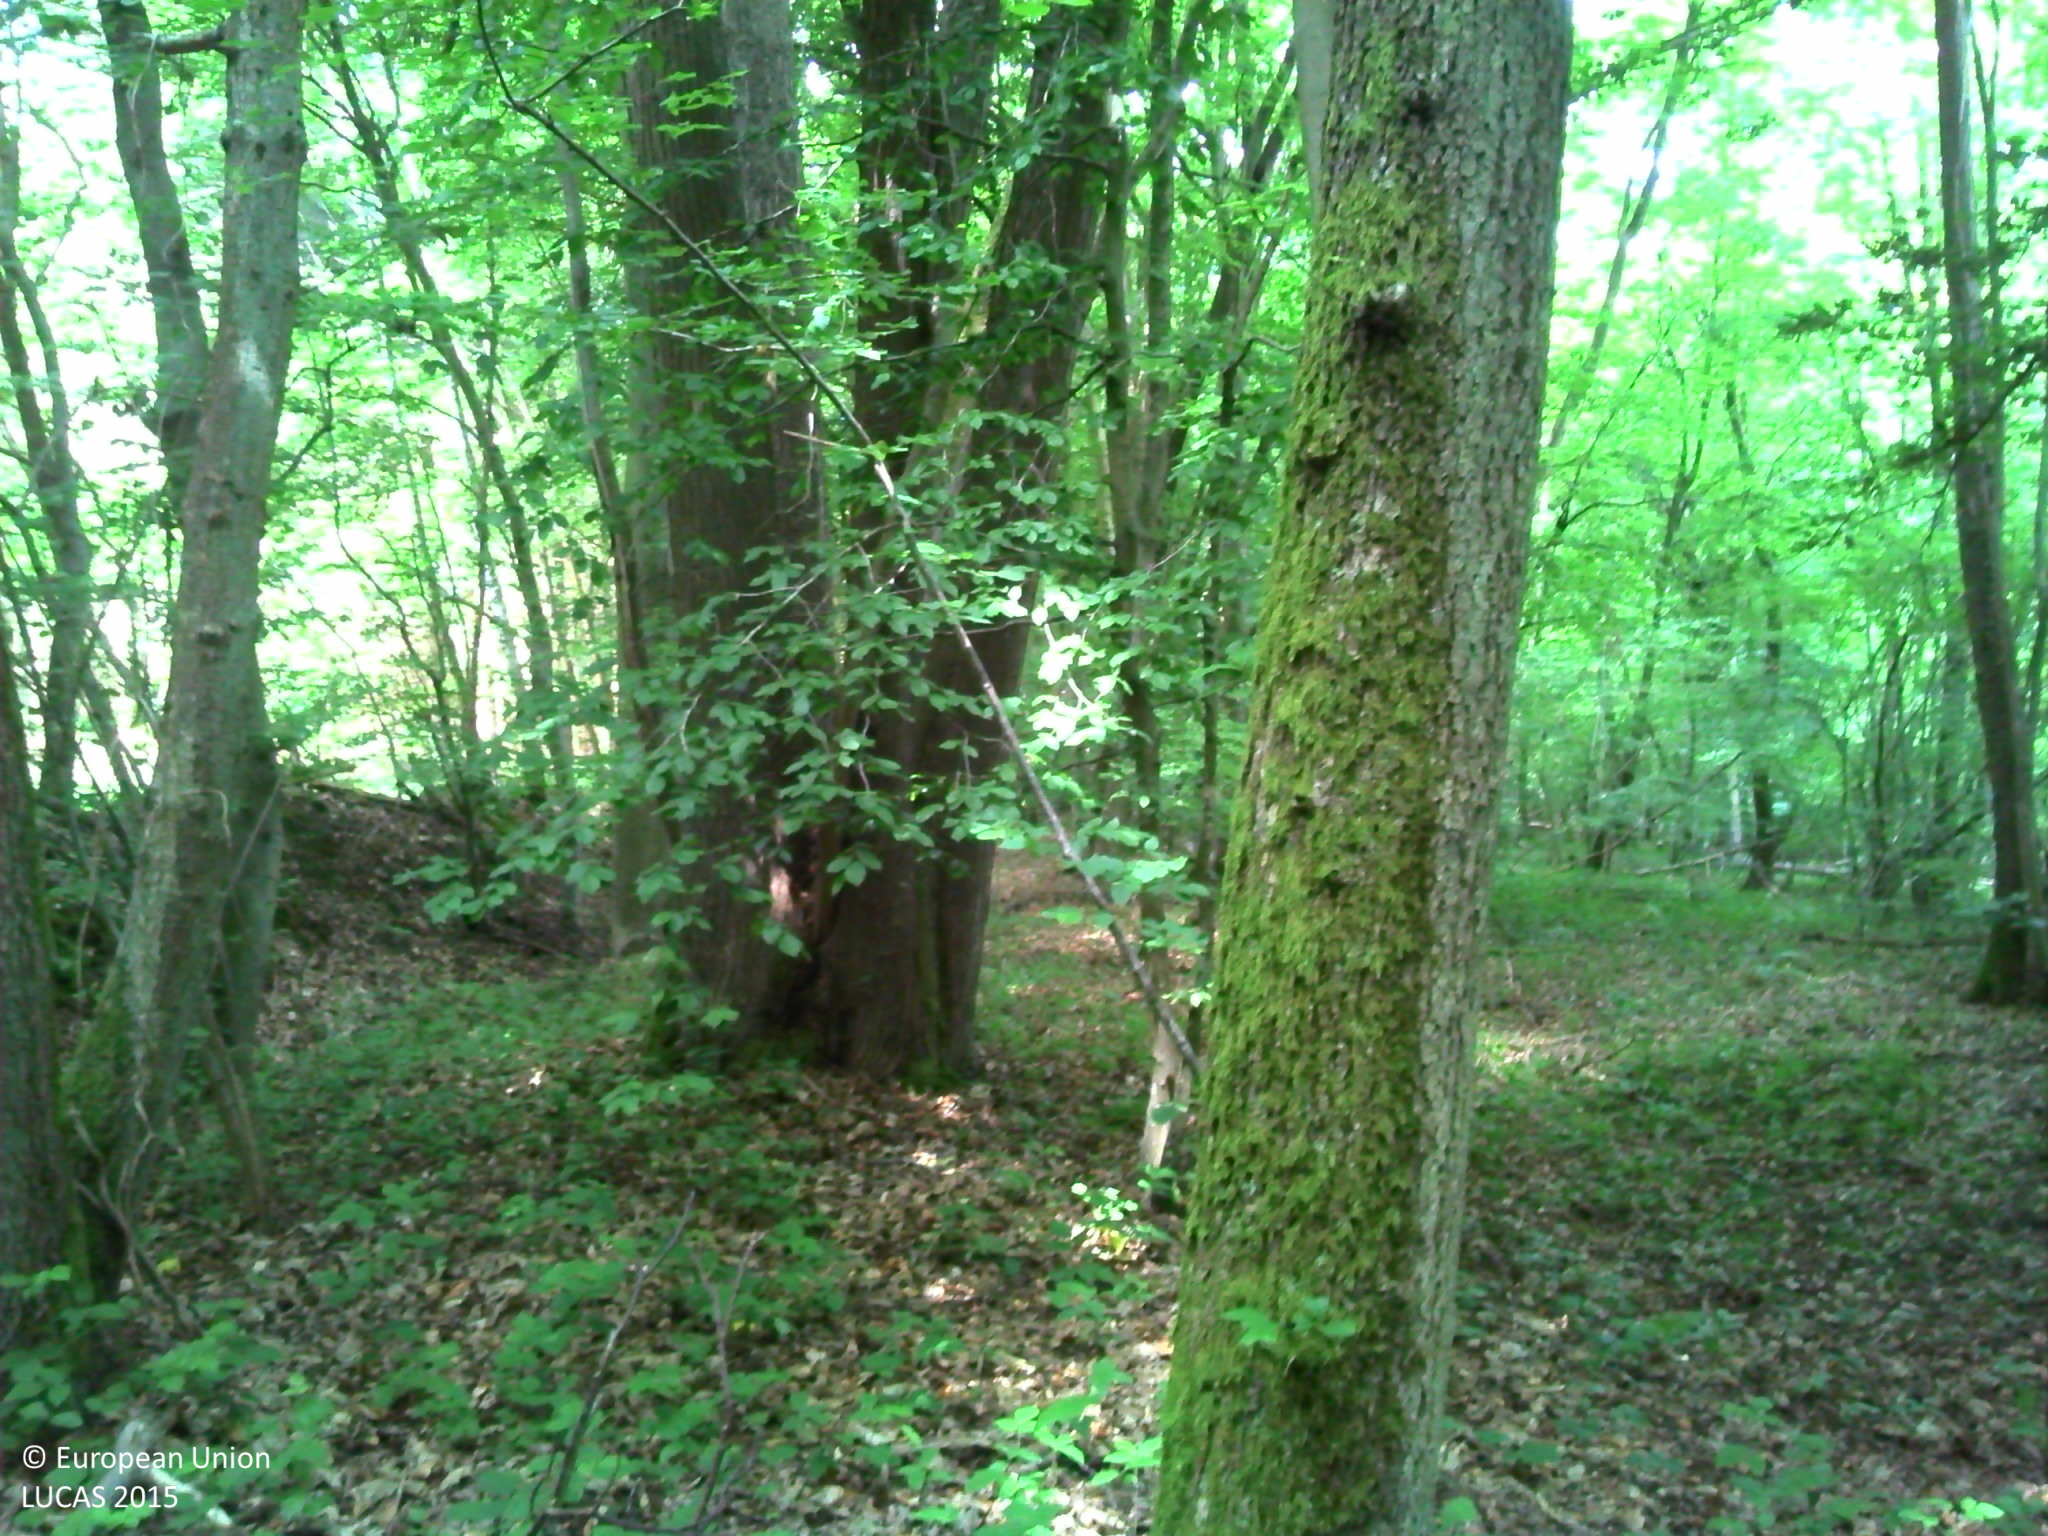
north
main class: Woodland
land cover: Broadleaved woodland
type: mesophytic deciduous forest
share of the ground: > 75 %
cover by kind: broadleaved forest trees 80 %, herbaceous plants 10 %, consolidated bare surface 10 %
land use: Forestry
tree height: > 5 m
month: June
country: FR
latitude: 49.2536
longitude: 1.0619
